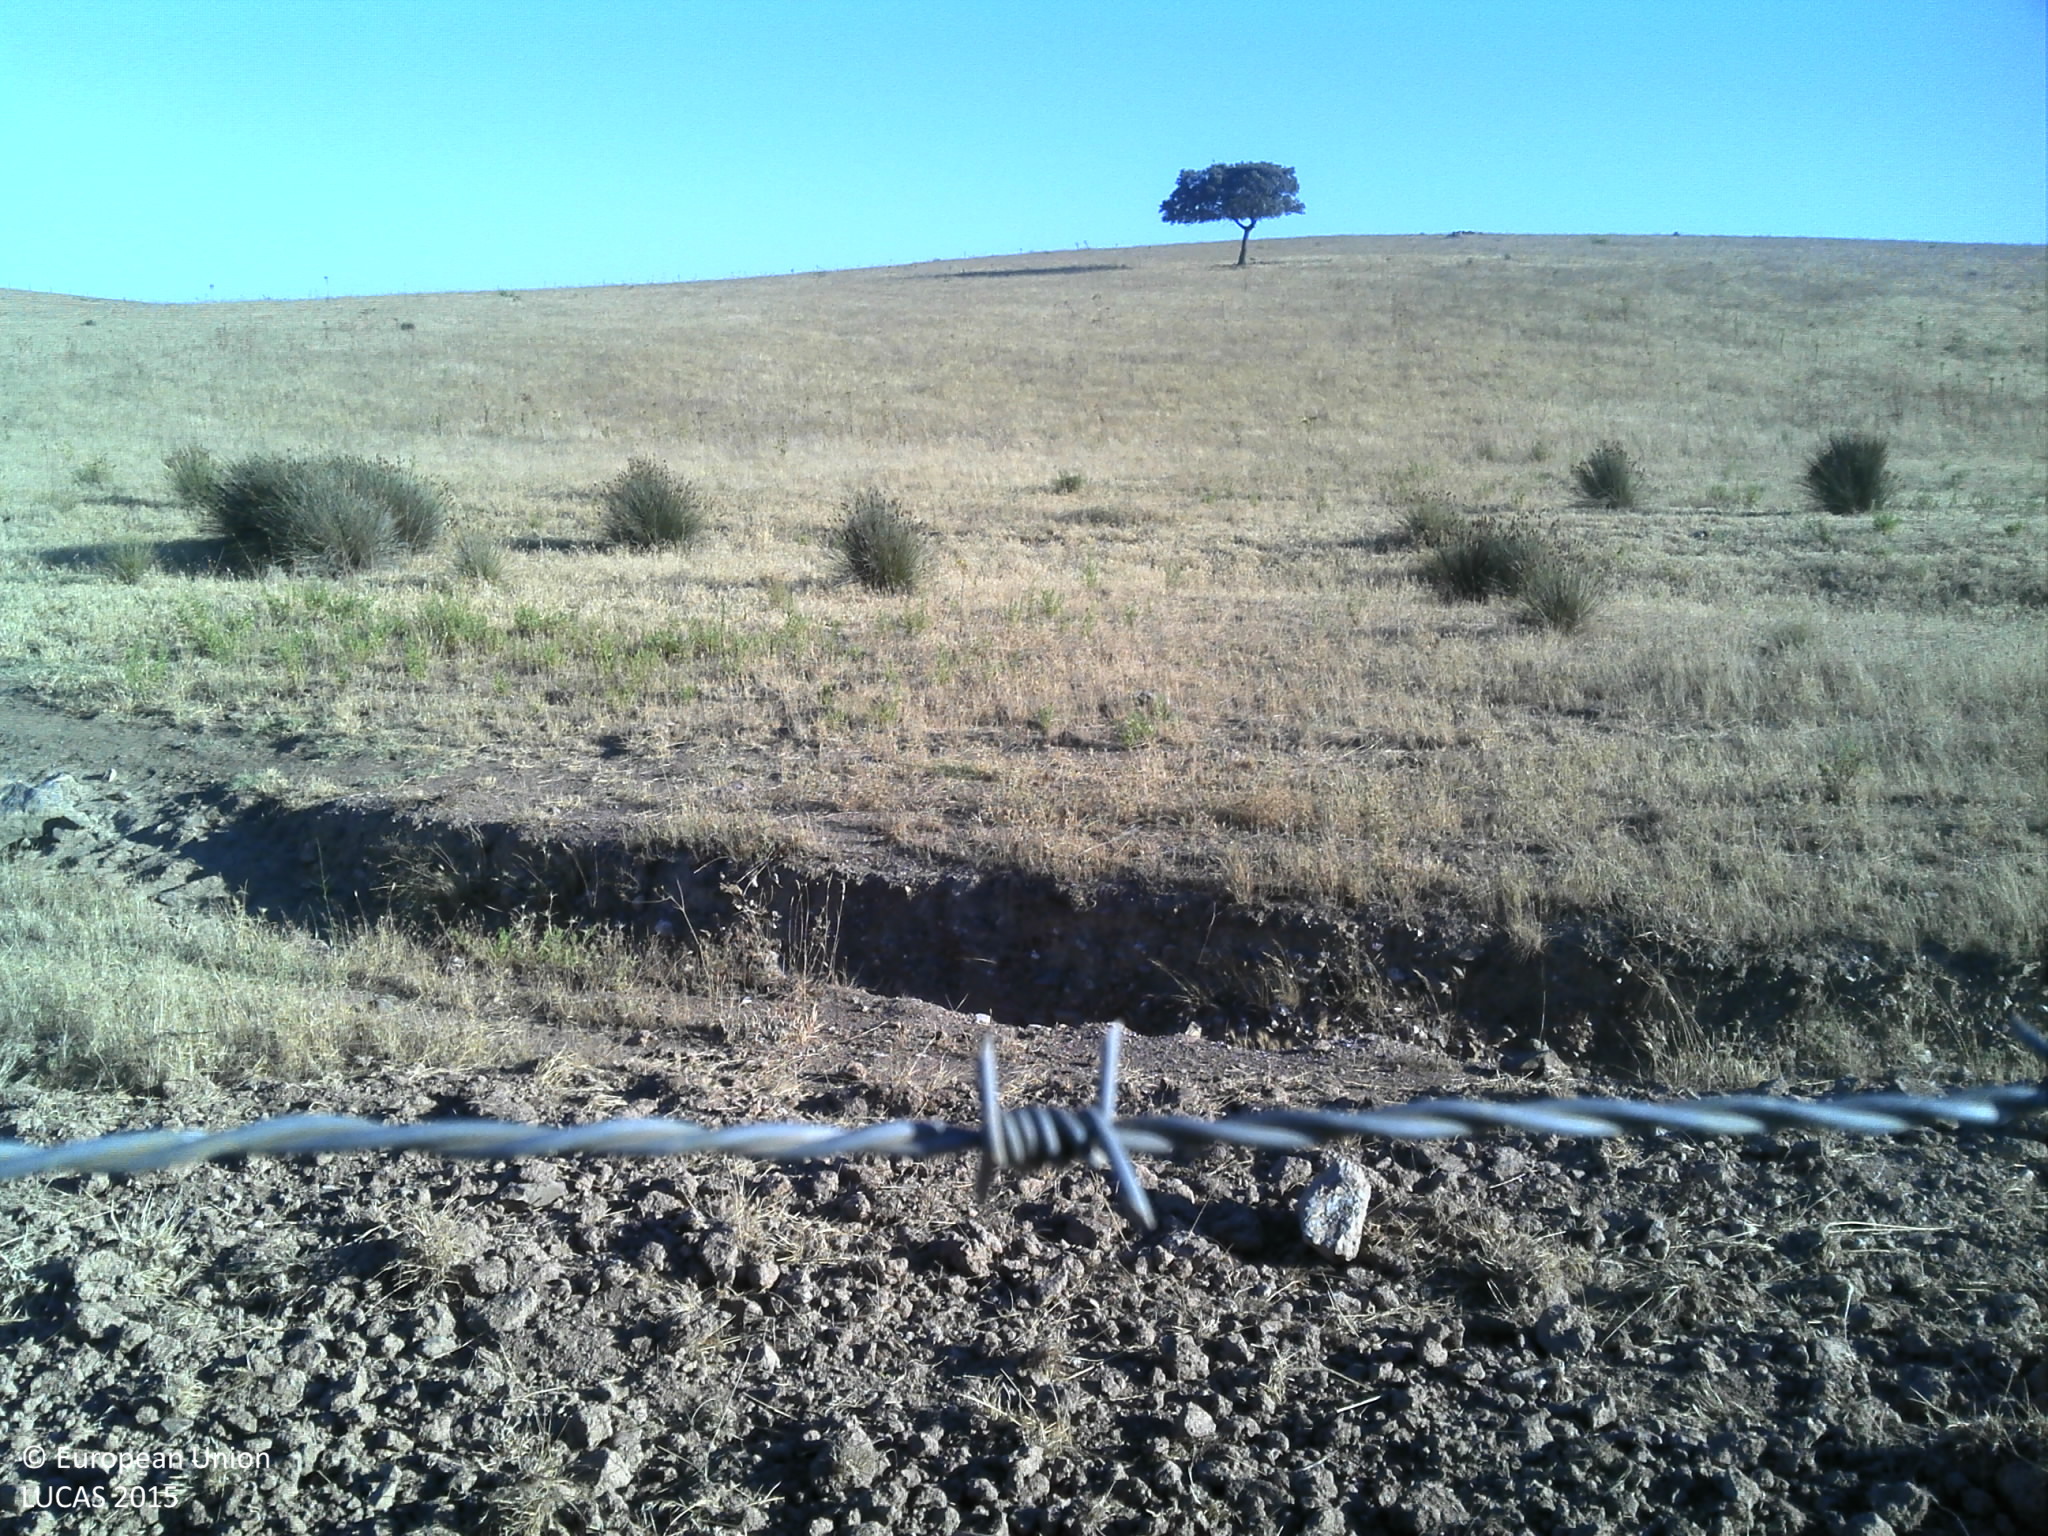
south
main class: Grassland
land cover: Grassland without tree/shrub cover
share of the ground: > 75 %
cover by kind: herbaceous plants 95 %, unconsolidated bare surface 5 %
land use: Agriculture (excluding fallow land and kitchen gardens)
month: July
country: PT
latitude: 37.8792
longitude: -8.0264
